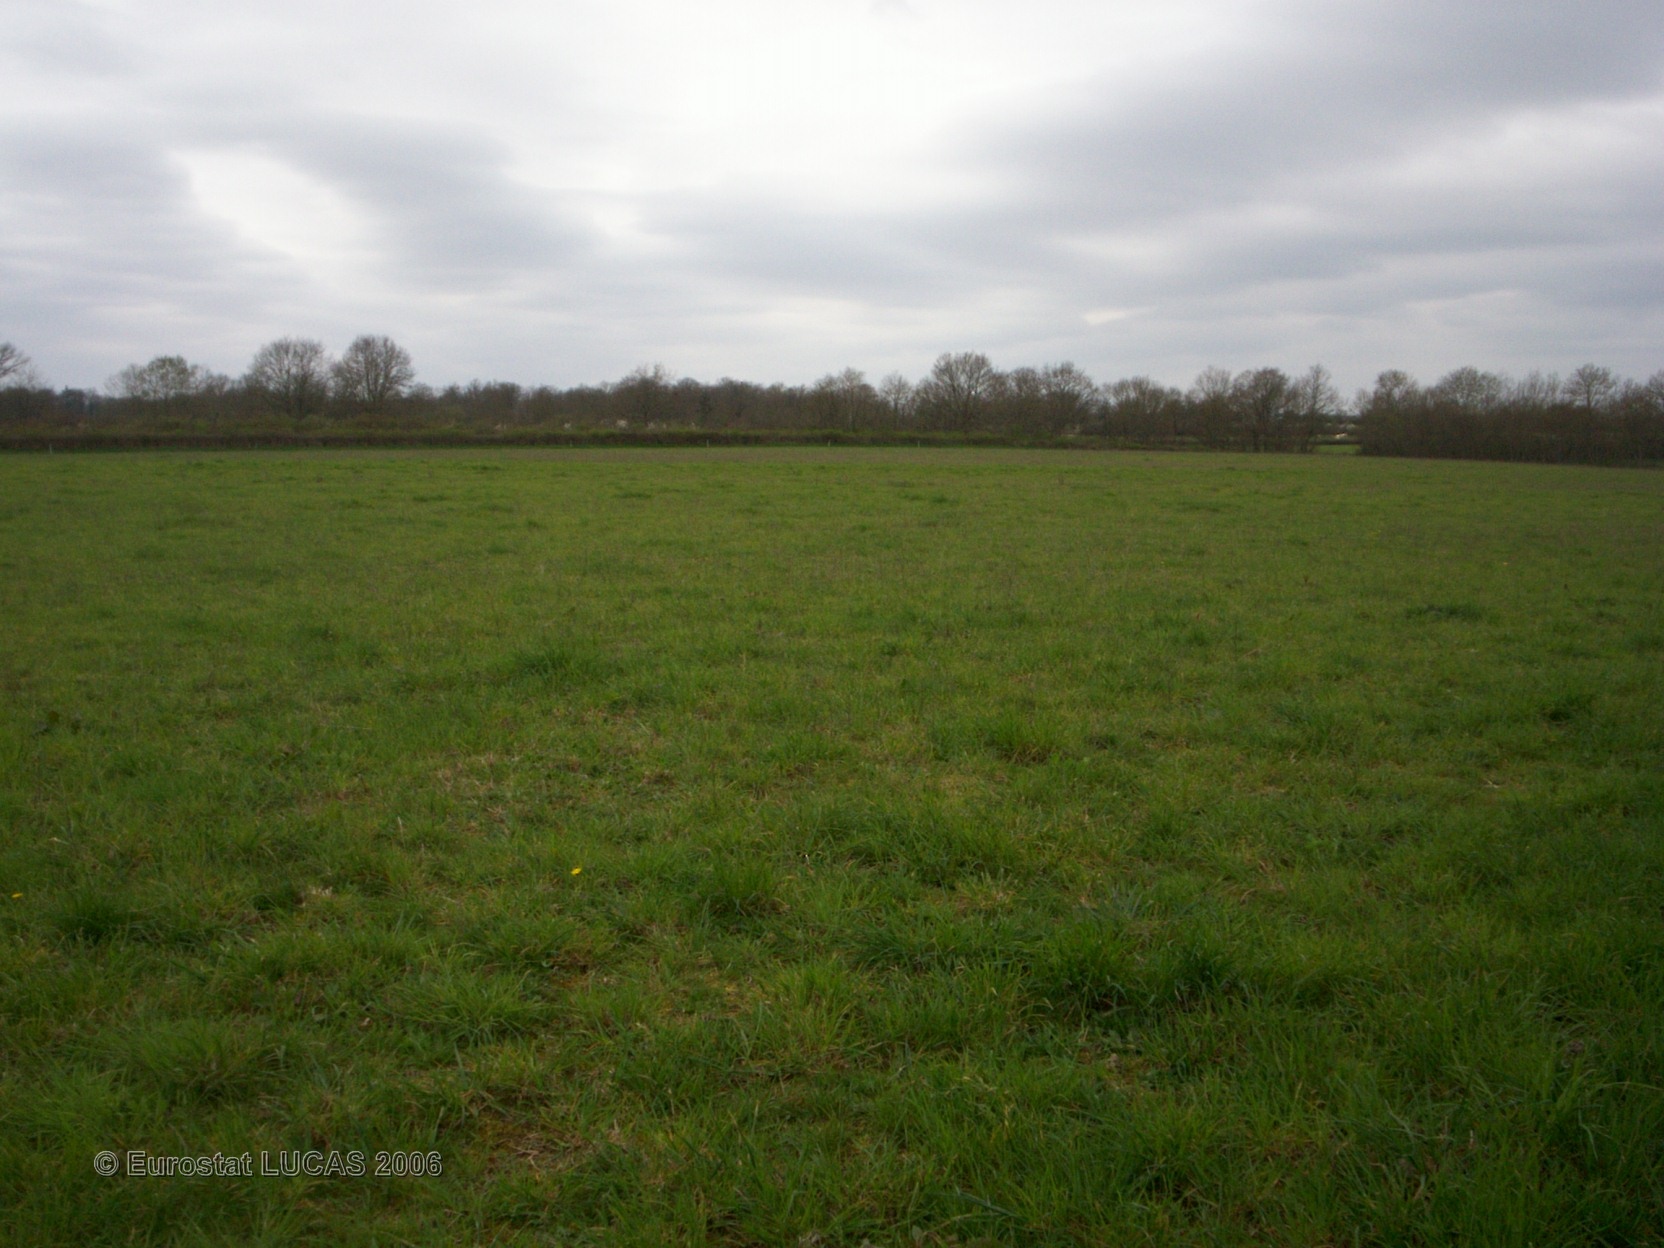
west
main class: Grassland
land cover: Grassland without tree/shrub cover
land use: Agriculture (excluding fallow land and kitchen gardens)
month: April
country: FR
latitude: 46.6984
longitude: 2.9736
